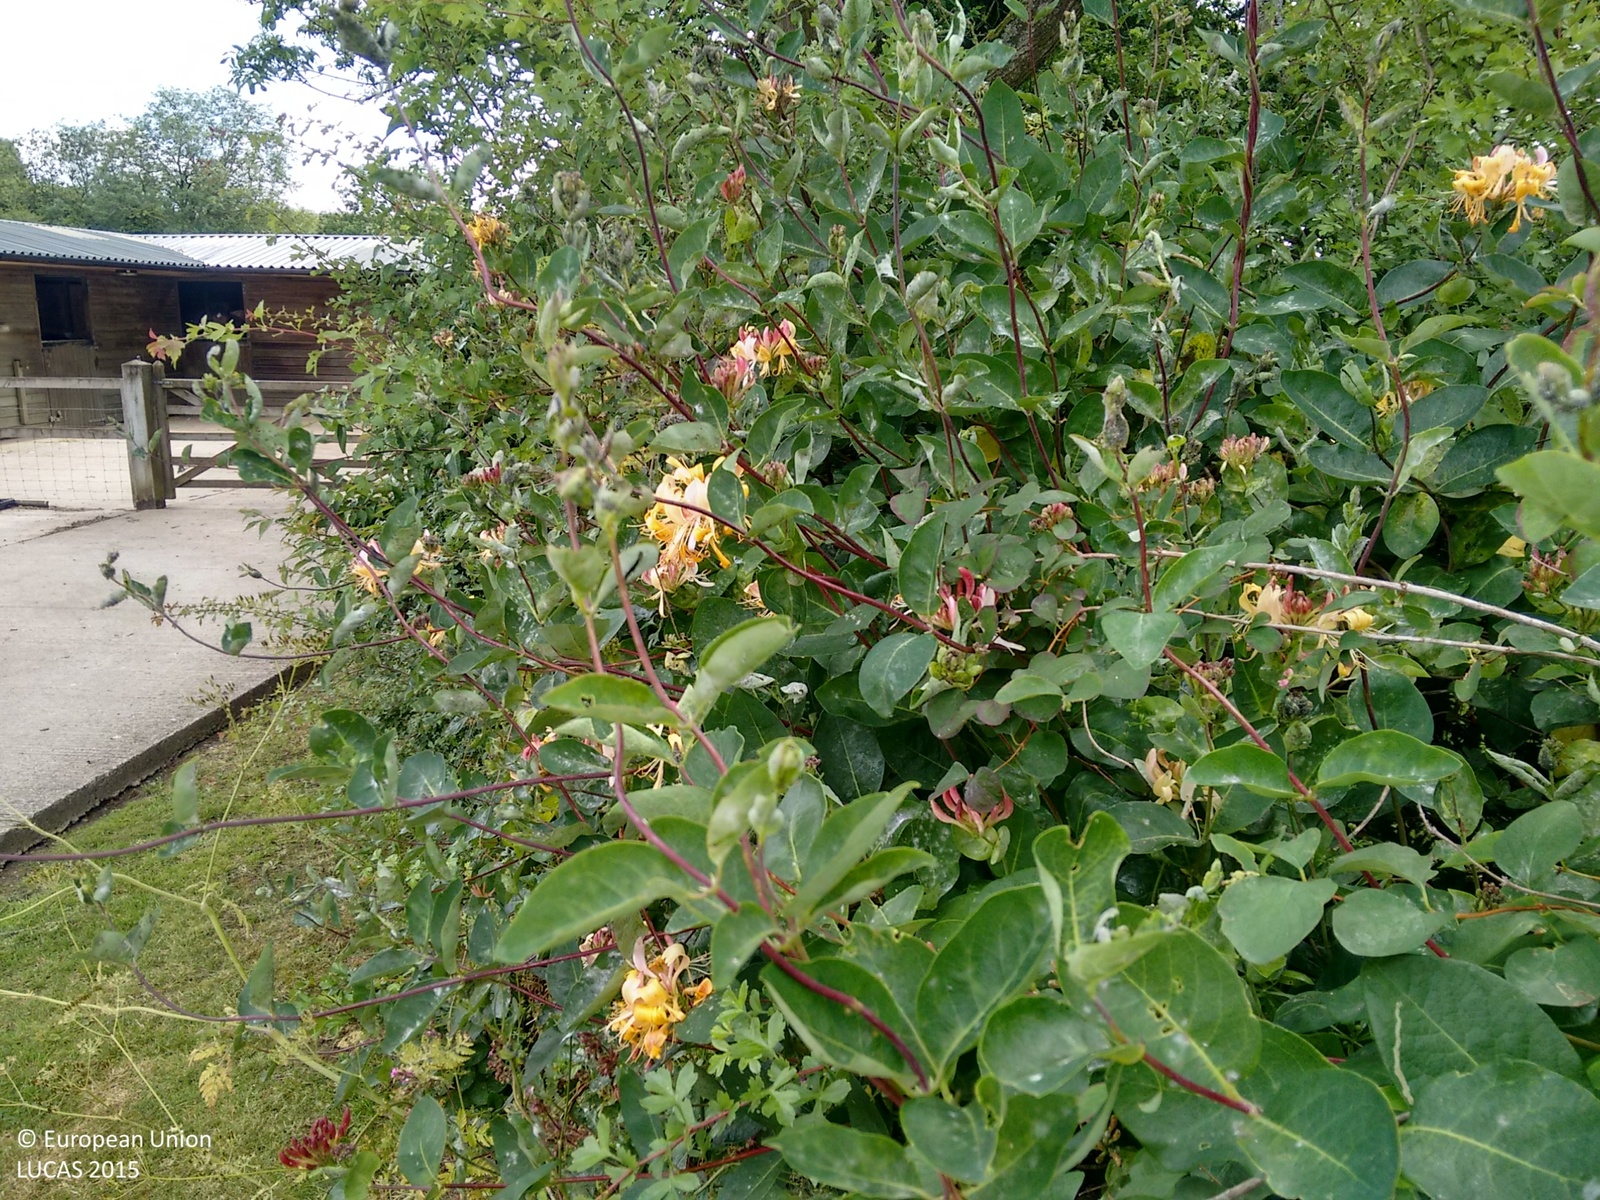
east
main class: Grassland
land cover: Grassland without tree/shrub cover
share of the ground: > 75 %
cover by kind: herbaceous plants 100 %
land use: Residential
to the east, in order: Managed hedges; Artificial constructions in urban areas; Grassland without tree/shrub cover; Fences; Grassland without tree/shrub cover; Ditches and canals; Fences; Managed hedges; Grassland without tree/shrub cover; Fences; Broadleaved woodland; Fences; Grassland without tree/shrub cover; Fences; Managed hedges; Grassland without tree/shrub cover
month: June
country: GB
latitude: 51.5613
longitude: -2.0463
